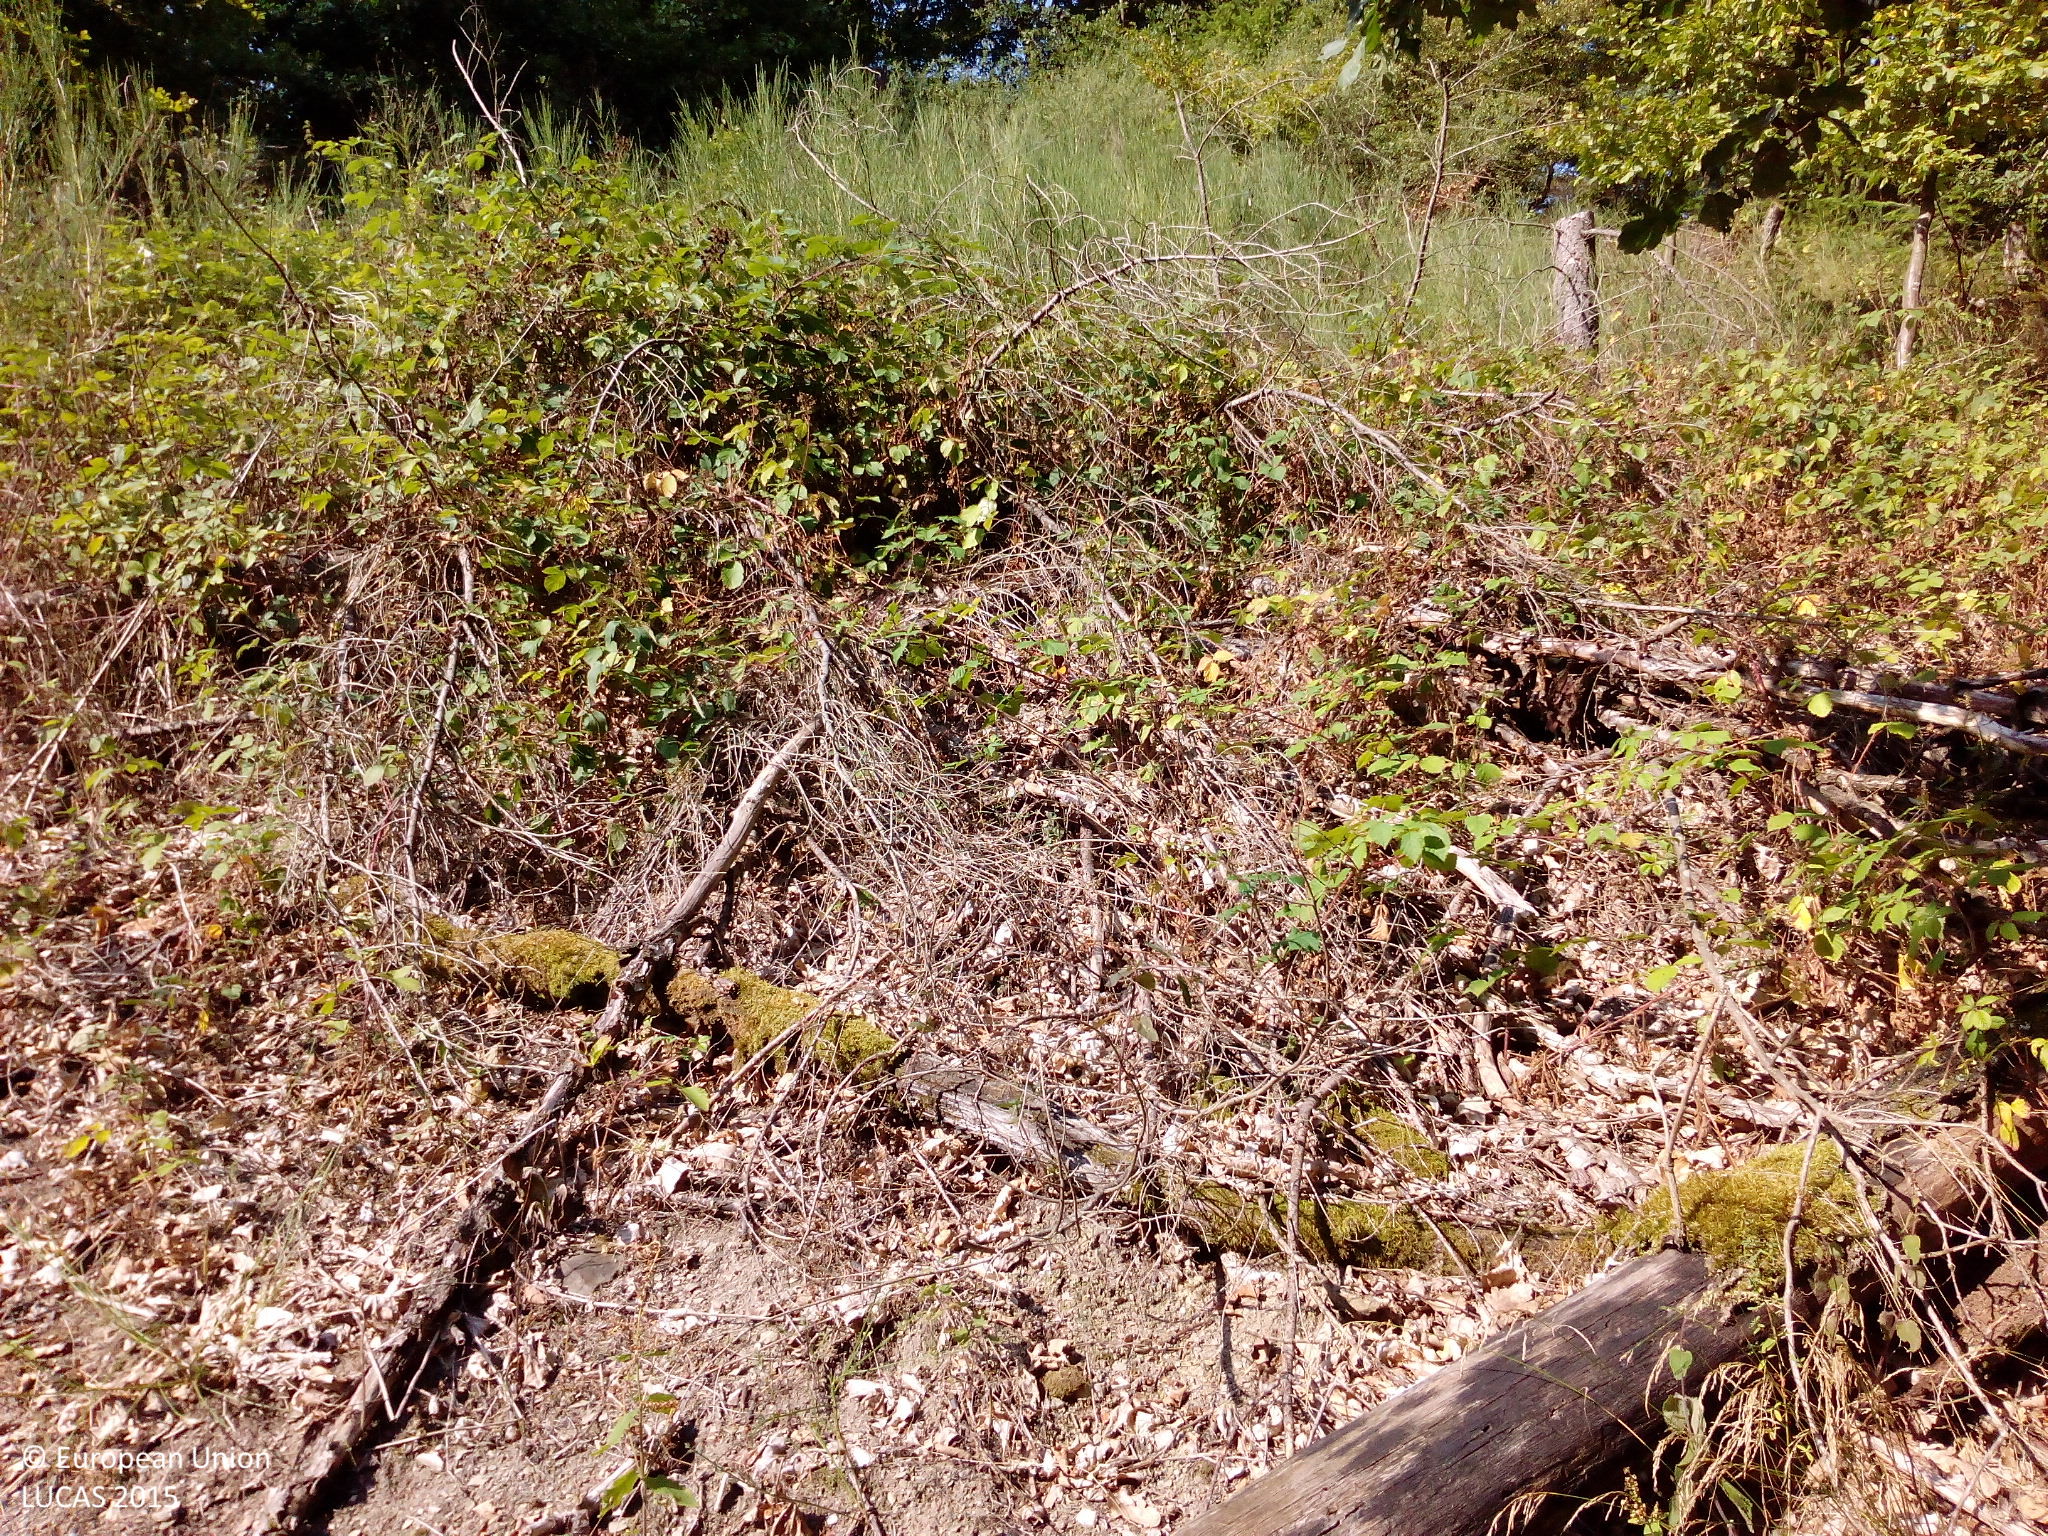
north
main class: Woodland
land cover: Broadleaved woodland
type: mesophytic deciduous forest
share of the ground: > 75 %
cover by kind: broadleaved forest trees 90 %, herbaceous plants 10 %
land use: Forestry
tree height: > 5 m
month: August
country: DE
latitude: 50.1388
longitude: 7.4958
